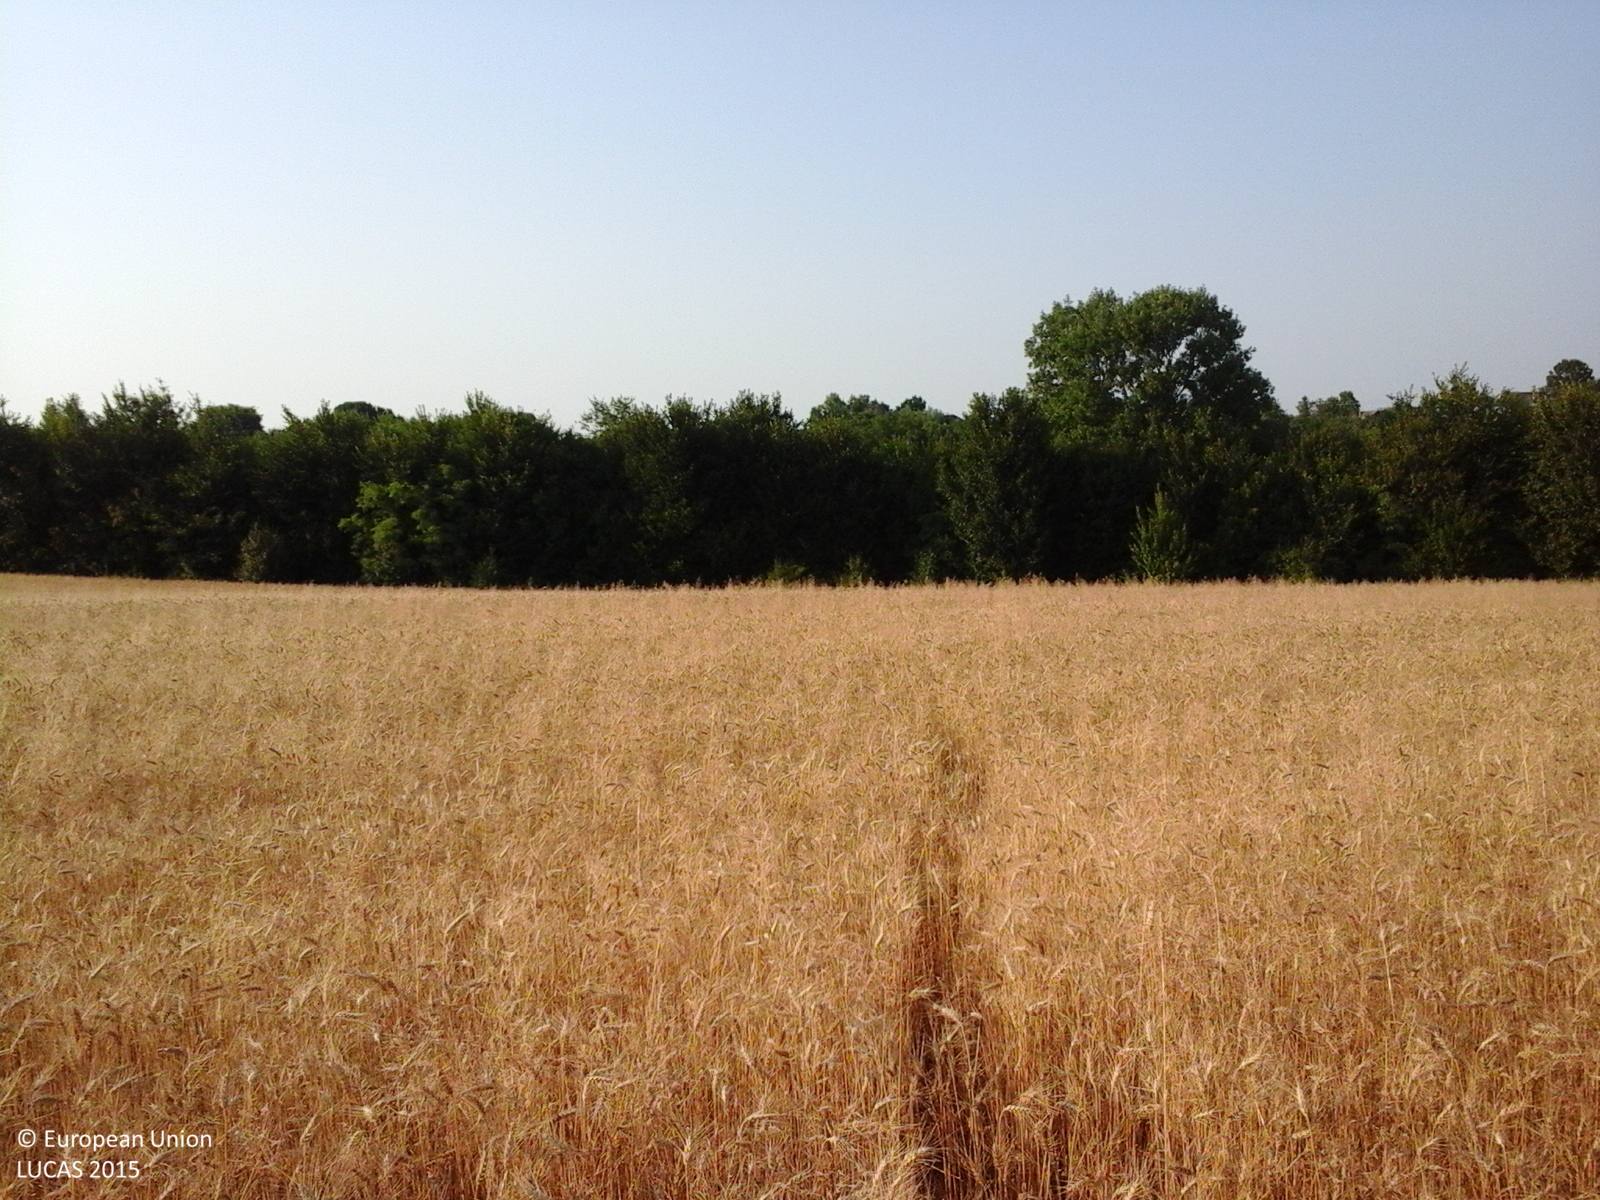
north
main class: Cropland
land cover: Common wheat
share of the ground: > 75 %
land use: Agriculture (excluding fallow land and kitchen gardens)
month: July
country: RO
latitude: 44.6882
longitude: 24.7005
